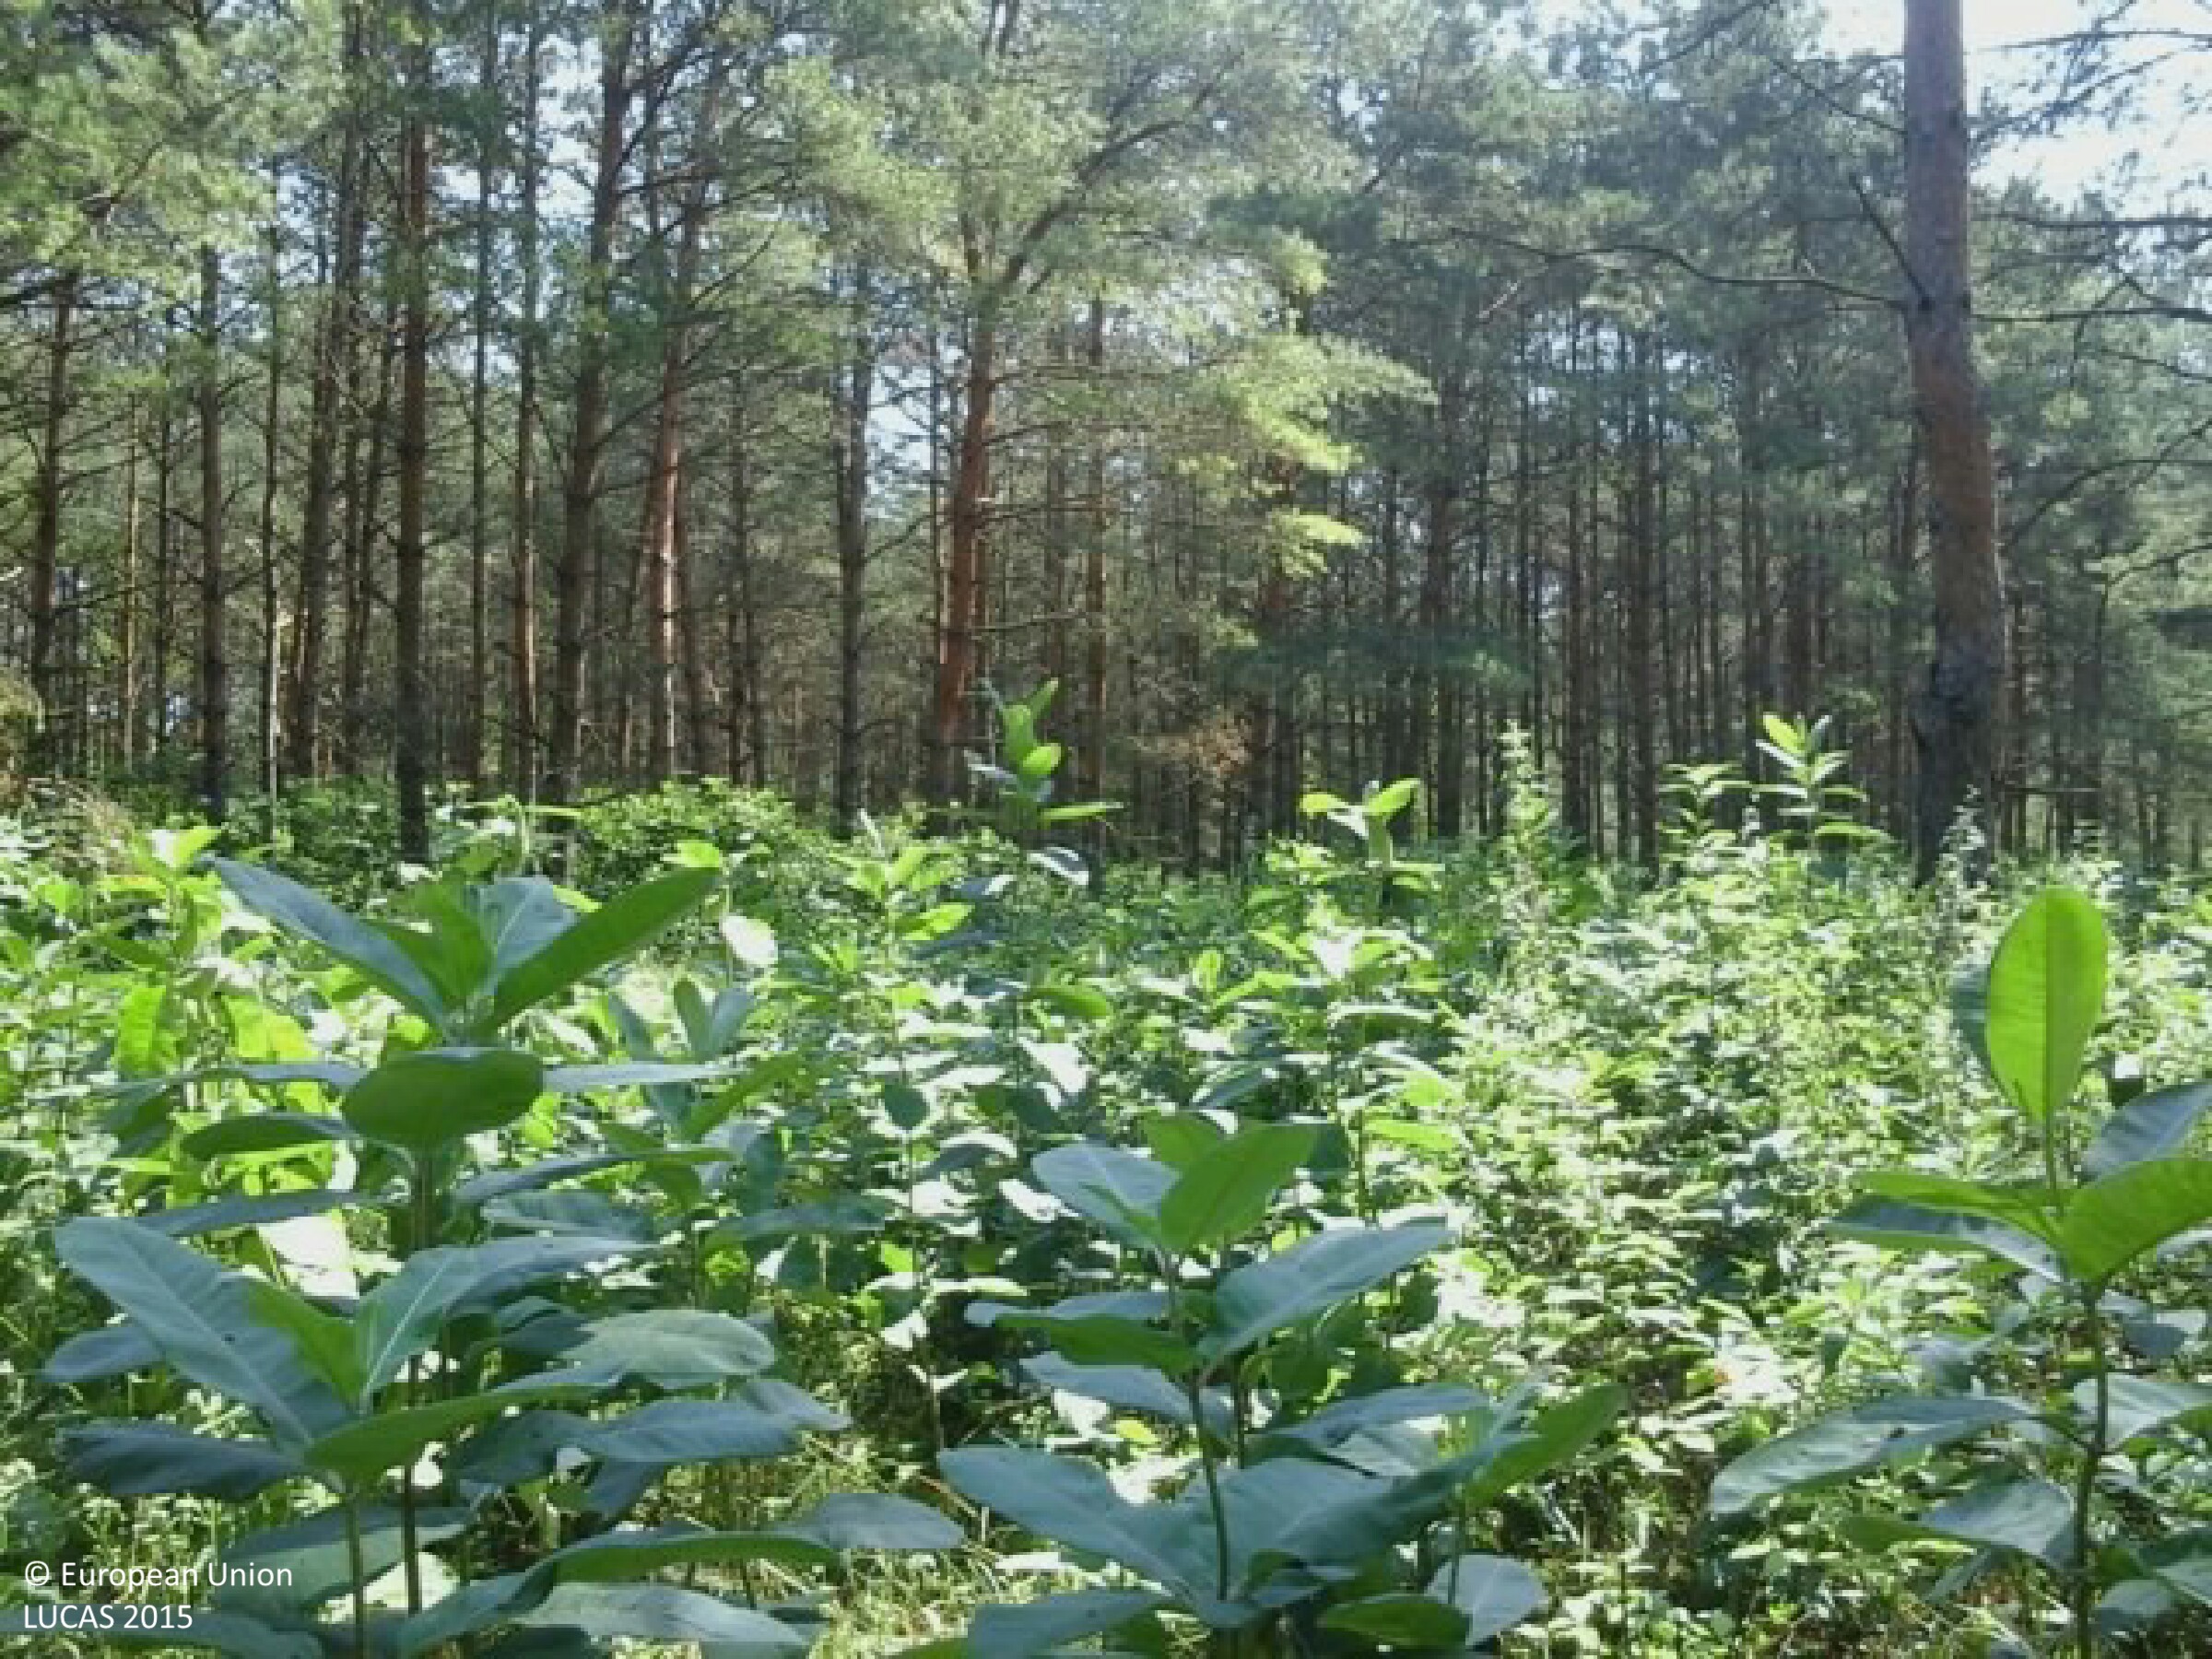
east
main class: Woodland
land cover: Pine dominated coniferous woodland
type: alpine coniferous forest
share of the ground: > 75 %
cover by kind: coniferous forest trees 75 %, herbaceous plants 15 %, shrubs 10 %
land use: Forestry
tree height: > 5 m
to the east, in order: Pine dominated coniferous woodland; Tracks; Spontaneously vegetated surfaces; Spruce dominated coniferous woodland; Broadleaved woodland; Ditches and canals; Broadleaved woodland; Grass margins; Tracks; Grass margins; Broadleaved woodland
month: August
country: HU
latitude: 47.3162
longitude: 19.3727
